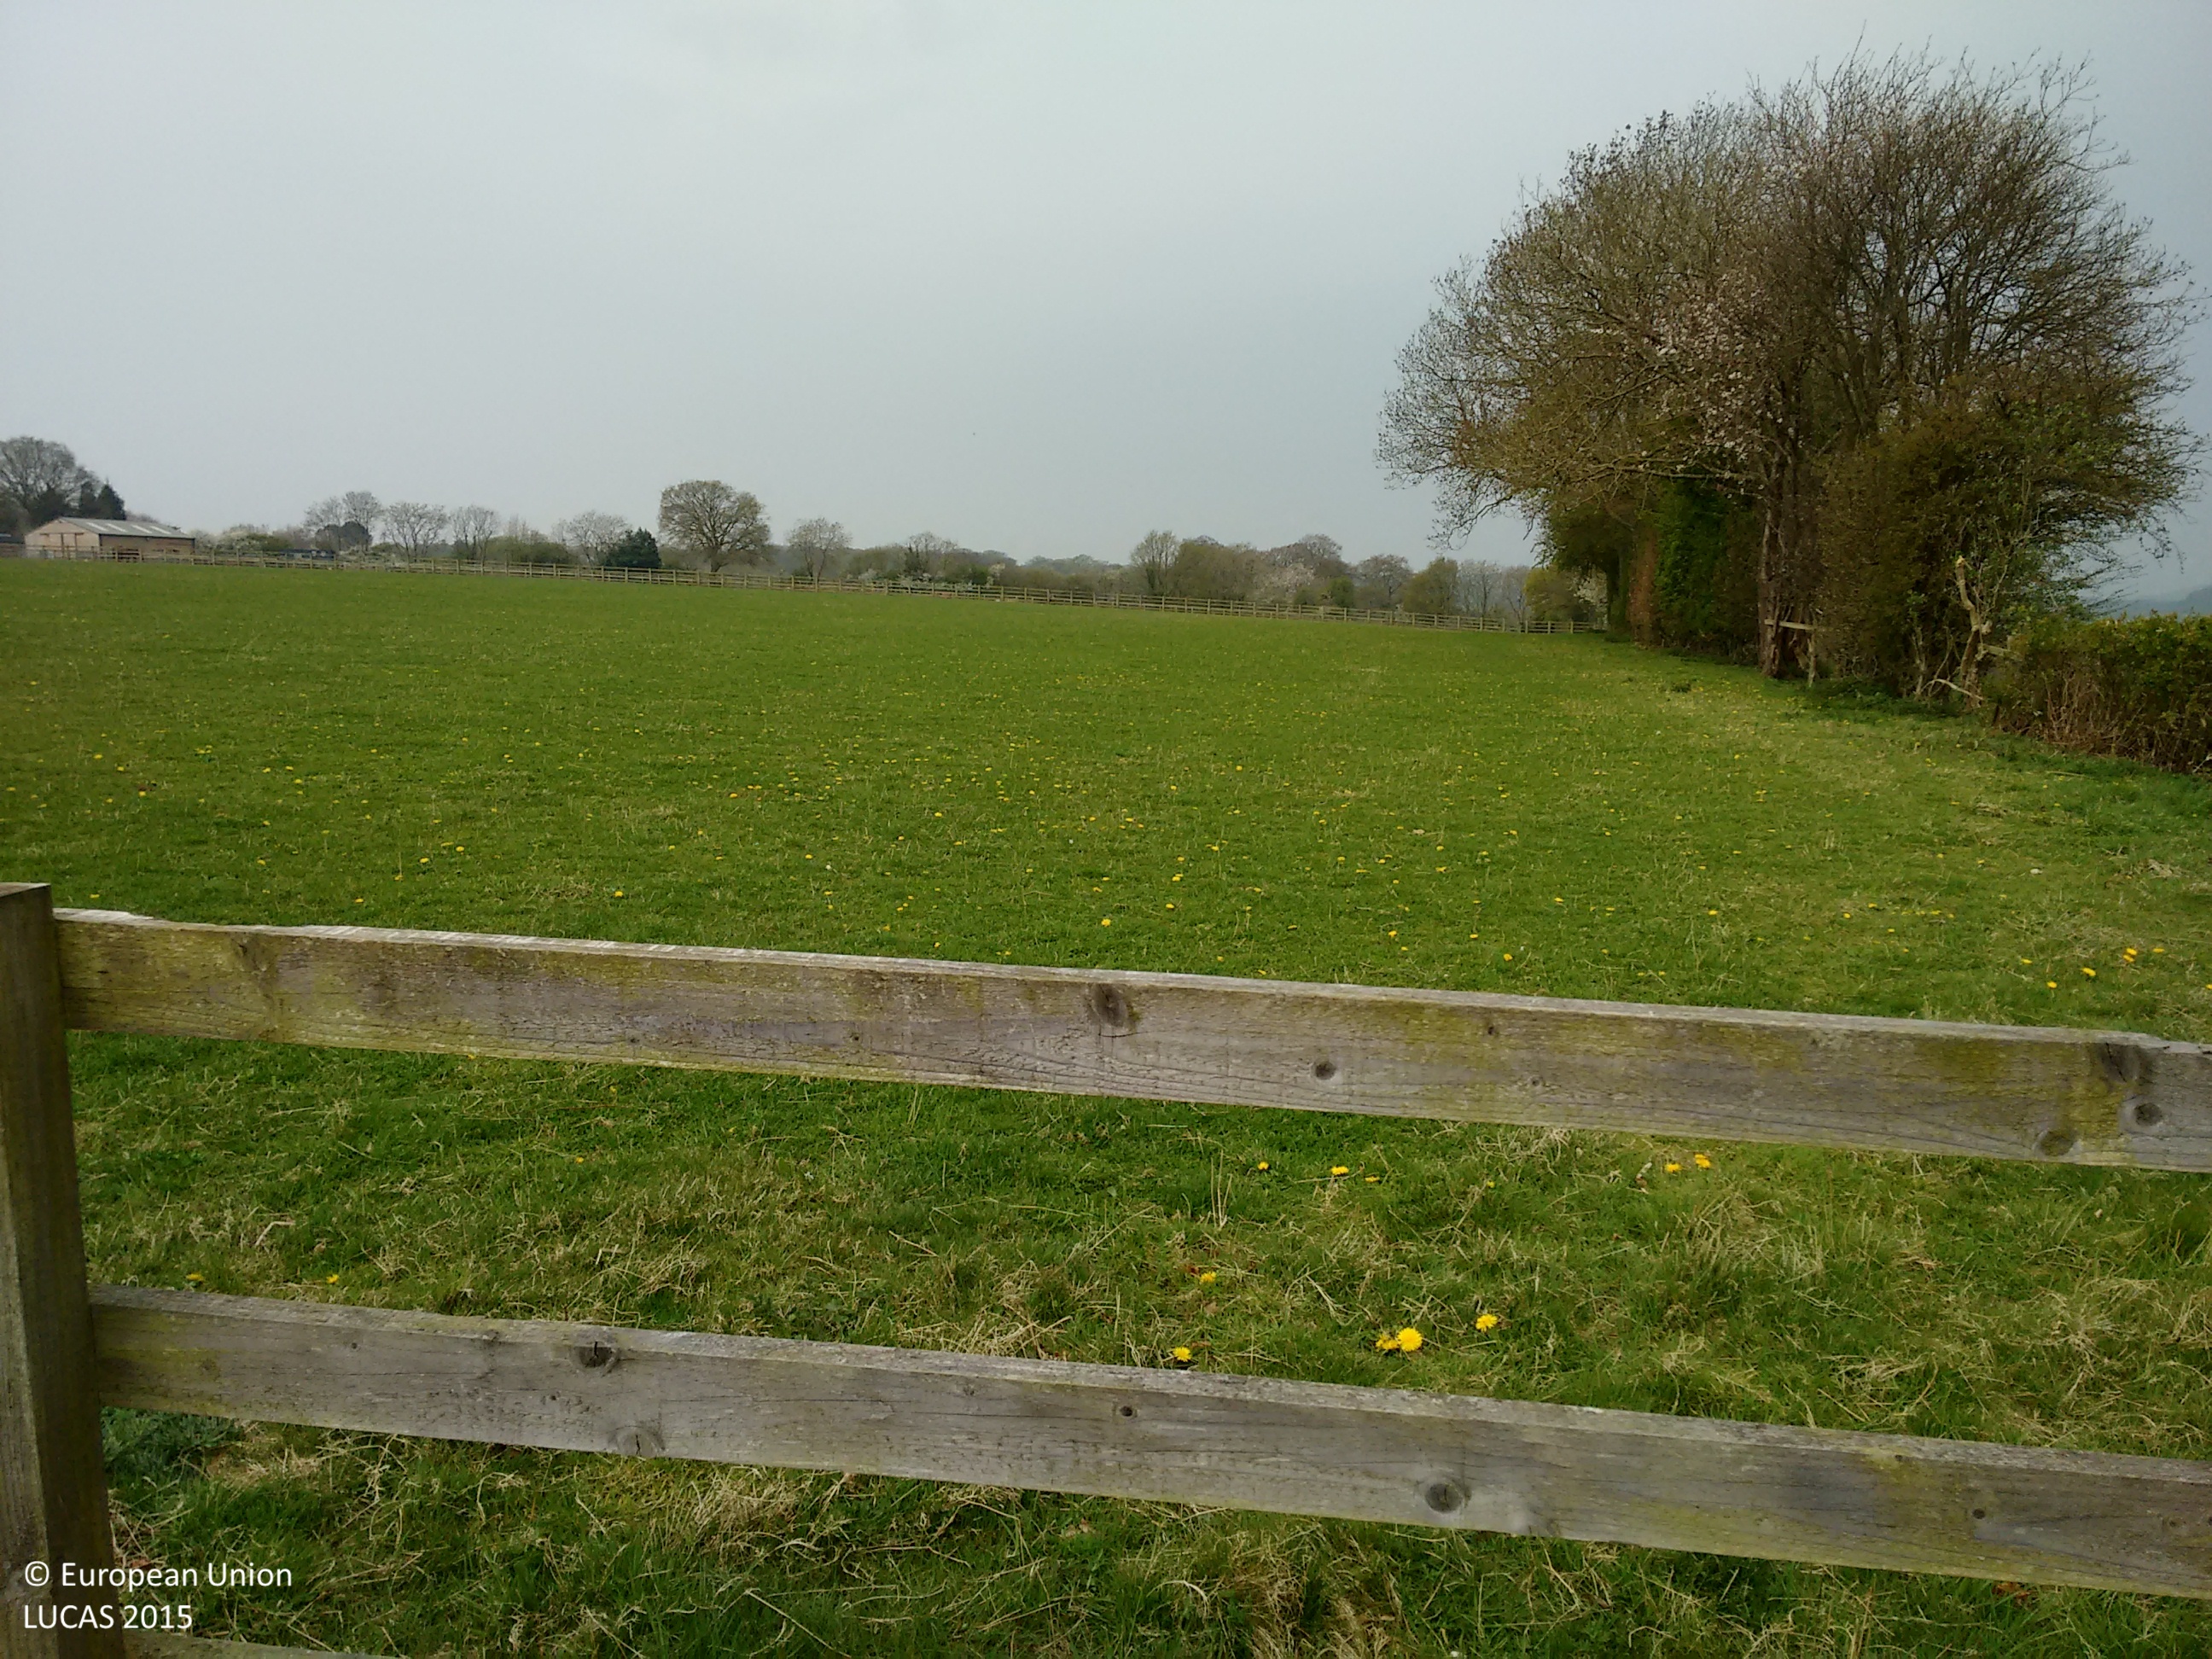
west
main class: Grassland
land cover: Grassland without tree/shrub cover
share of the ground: > 75 %
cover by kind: herbaceous plants 100 %
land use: Agriculture (excluding fallow land and kitchen gardens)
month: April
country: GB
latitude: 51.7077
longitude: -0.7356
